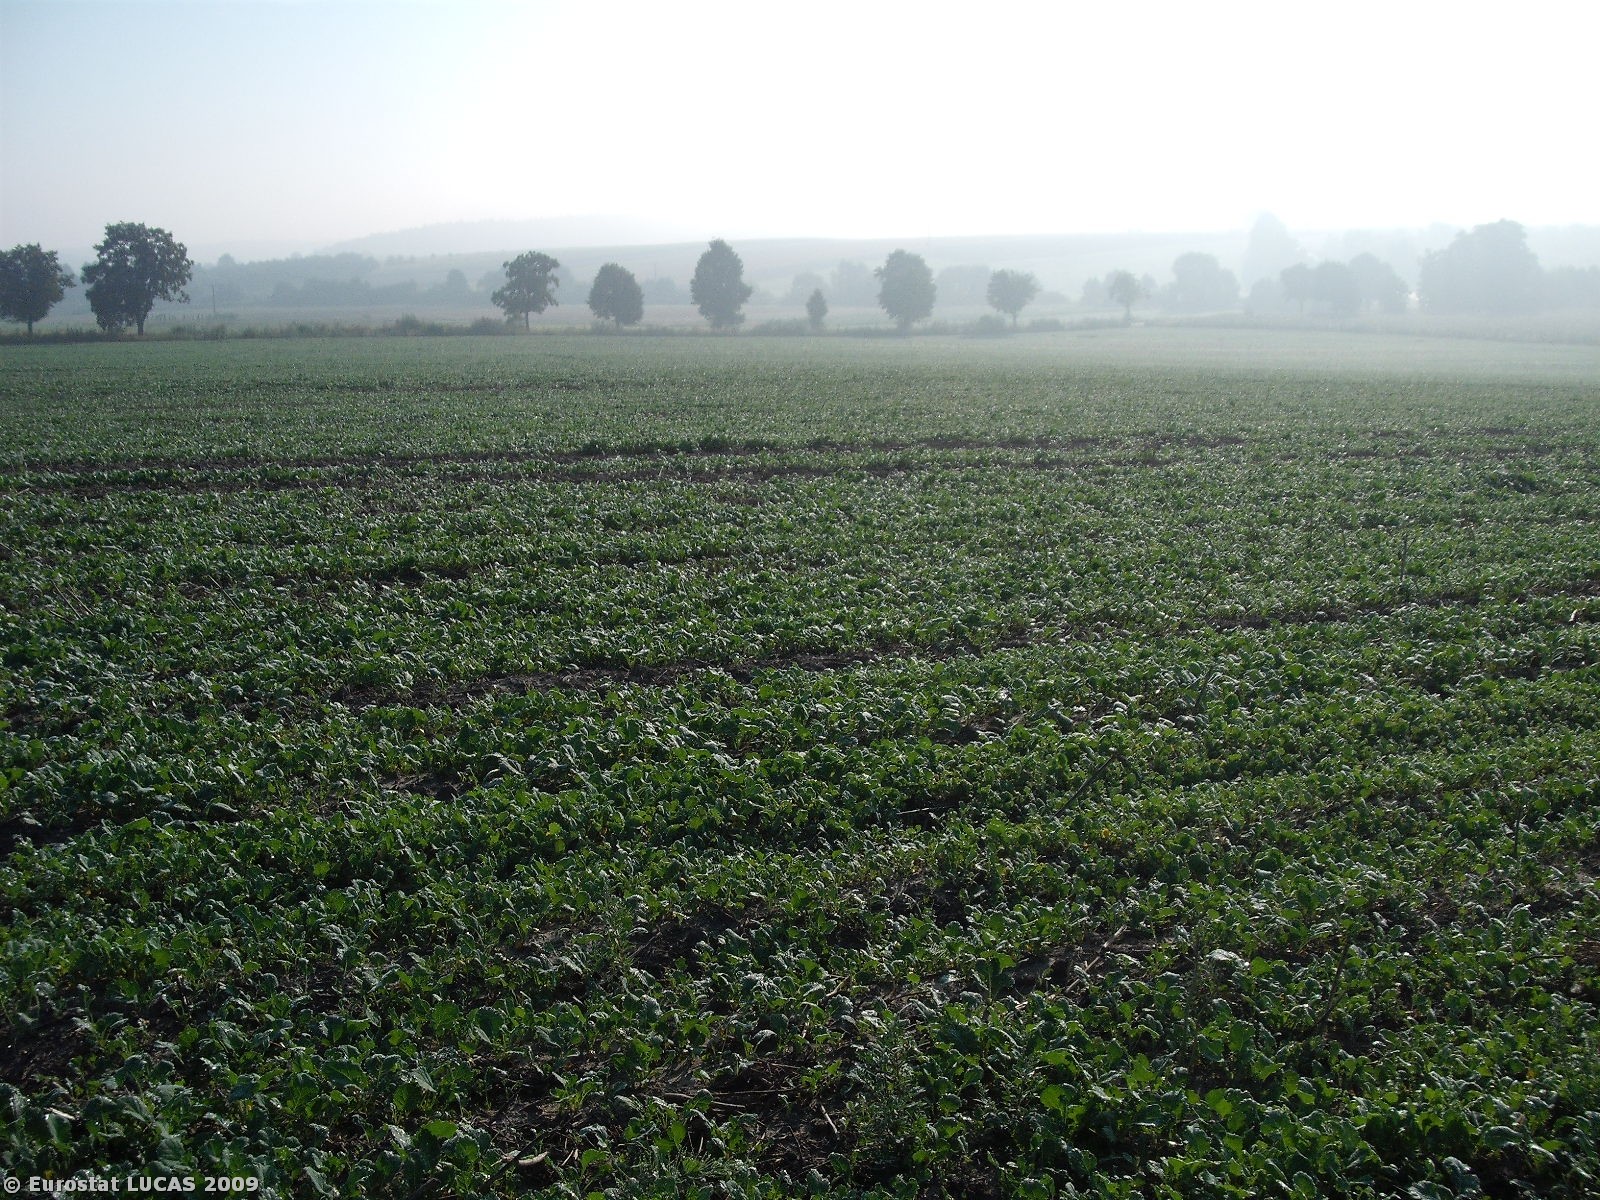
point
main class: Cropland
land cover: Rape and turnip rape
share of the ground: > 75 %
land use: Agriculture (excluding fallow land and kitchen gardens)
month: August
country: PL
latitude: 49.8724
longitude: 22.6883
